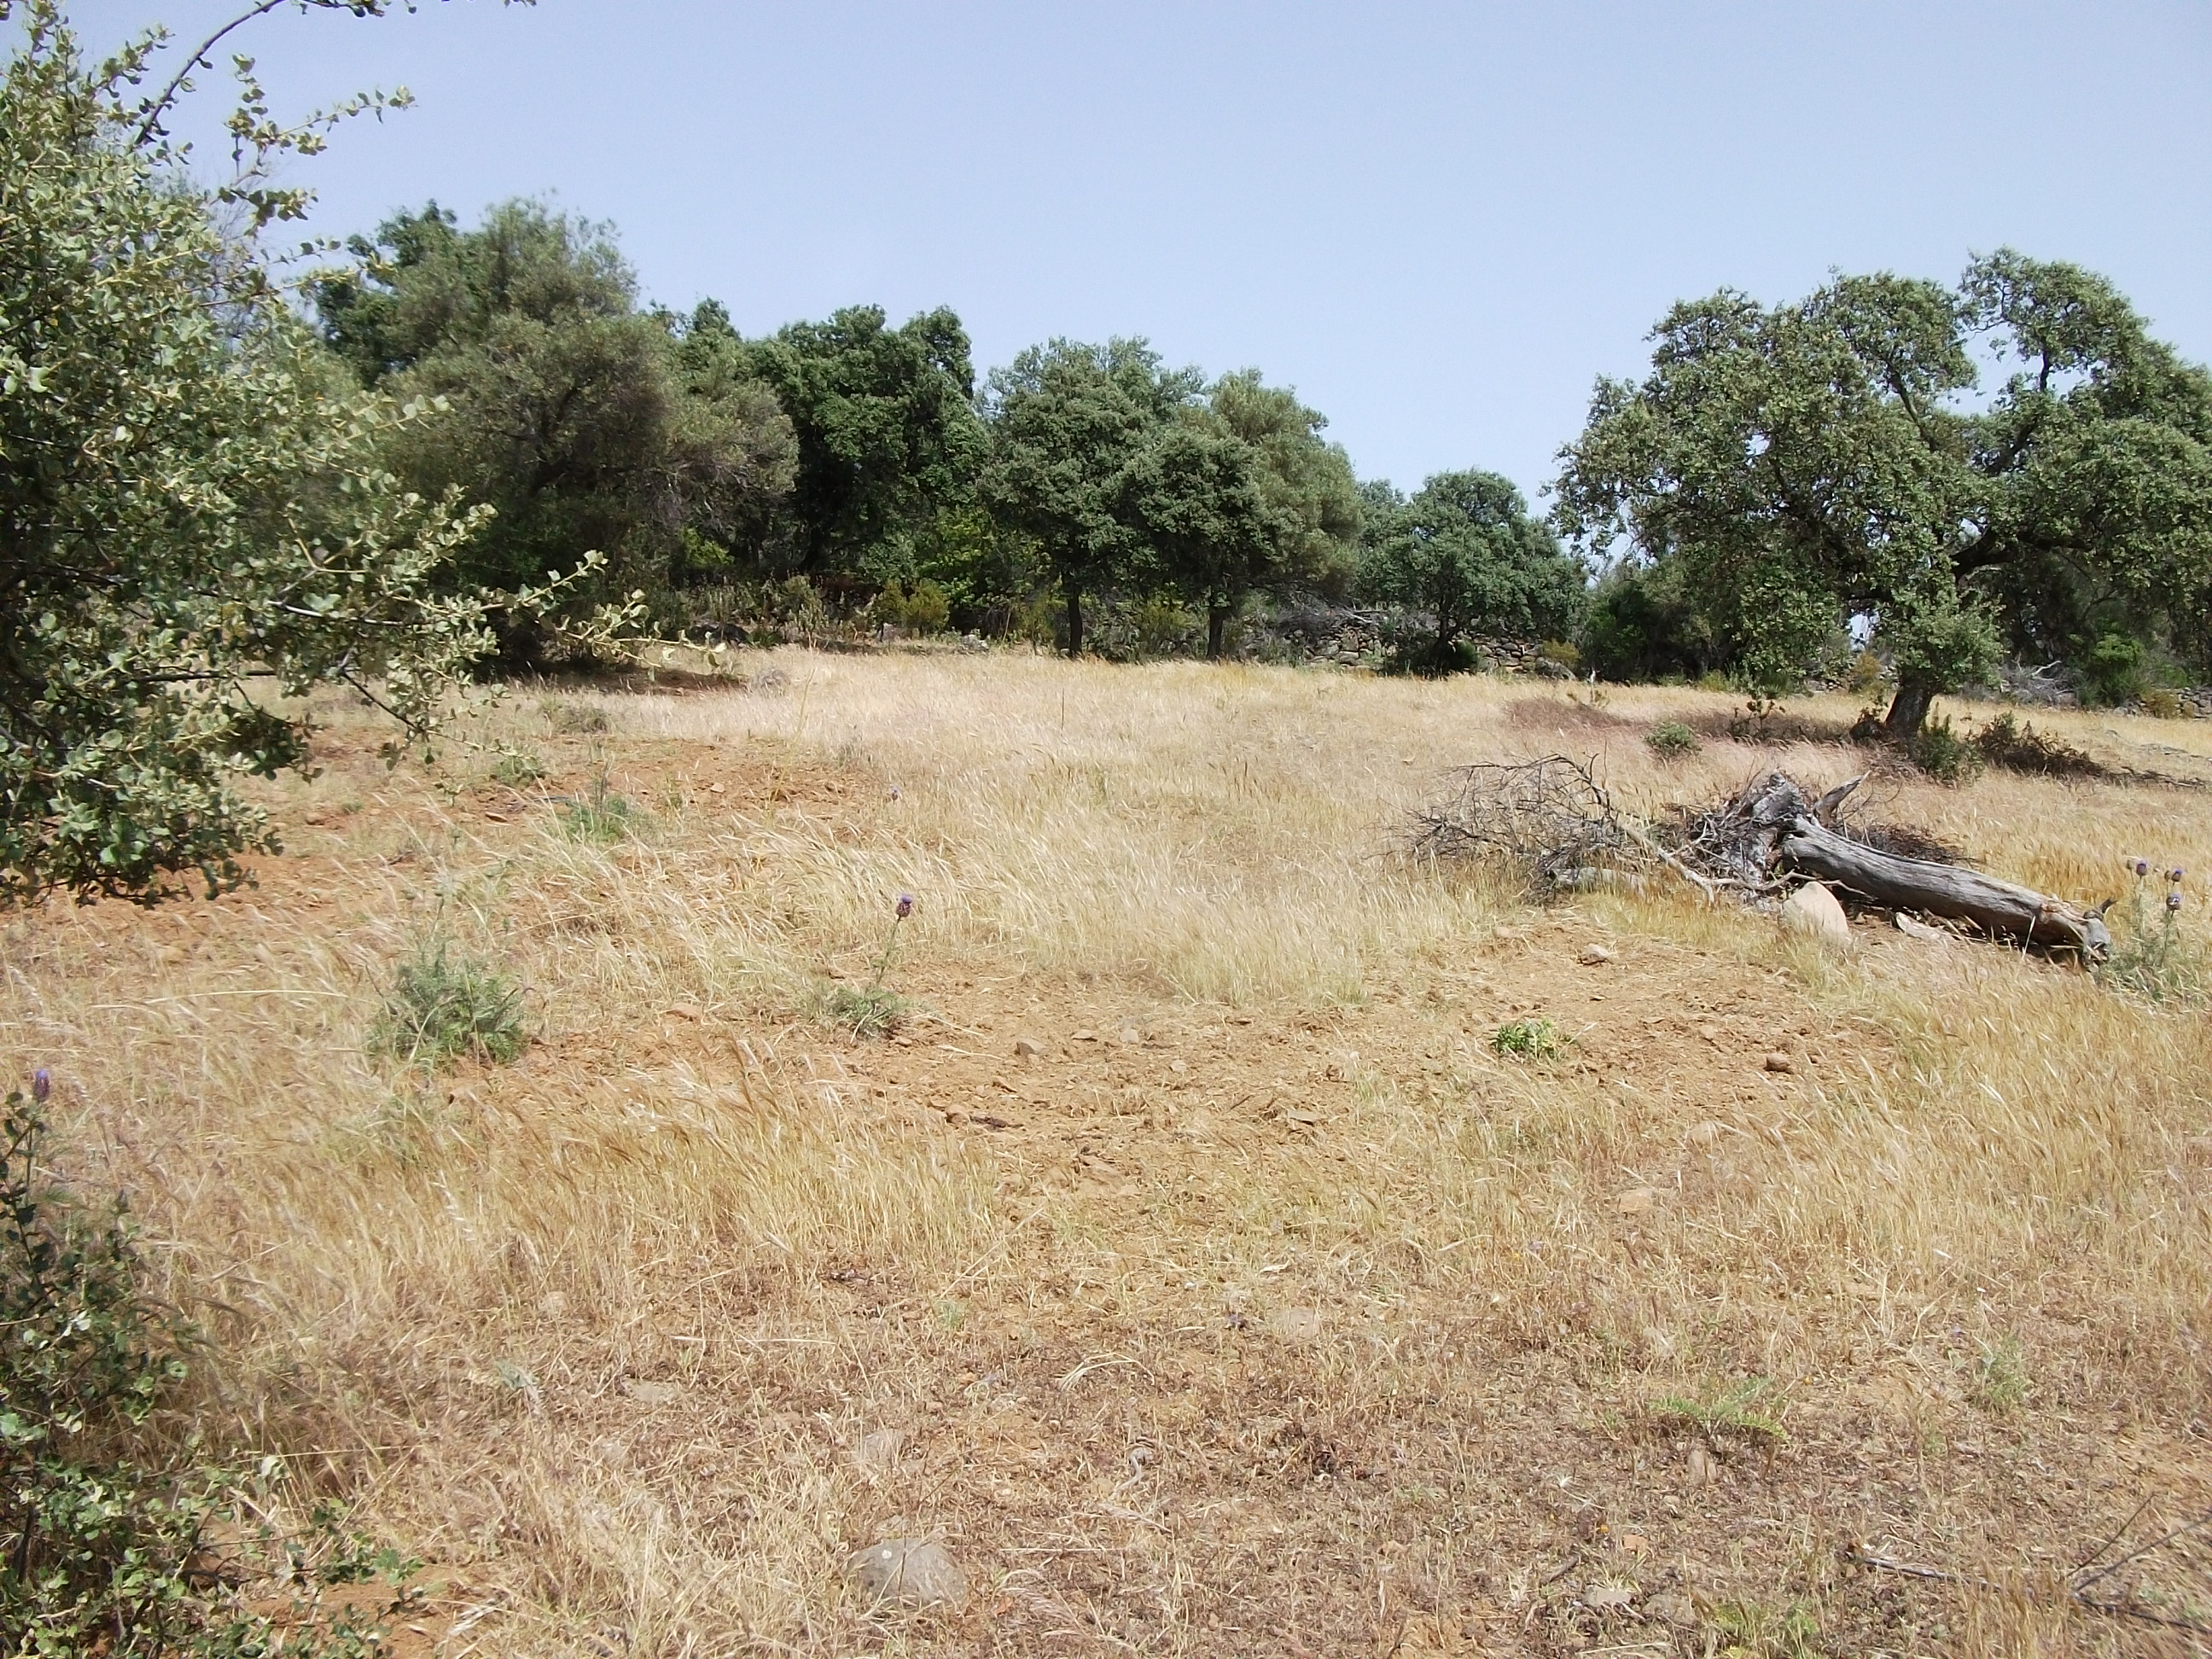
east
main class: Cropland
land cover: Olive groves
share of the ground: 25 - 50 %
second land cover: Spontaneously vegetated surfaces
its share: > 75 %
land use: Agriculture (excluding fallow land and kitchen gardens)
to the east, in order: Olive groves; Spontaneously vegetated surfaces; Broadleaved woodland; Dry stone walls; Fences; Abandoned hedges; Olive groves; Rock outcrops; Olive groves; Dry stone walls; Olive groves
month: May
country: ES
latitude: 37.7259
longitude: -6.9646
